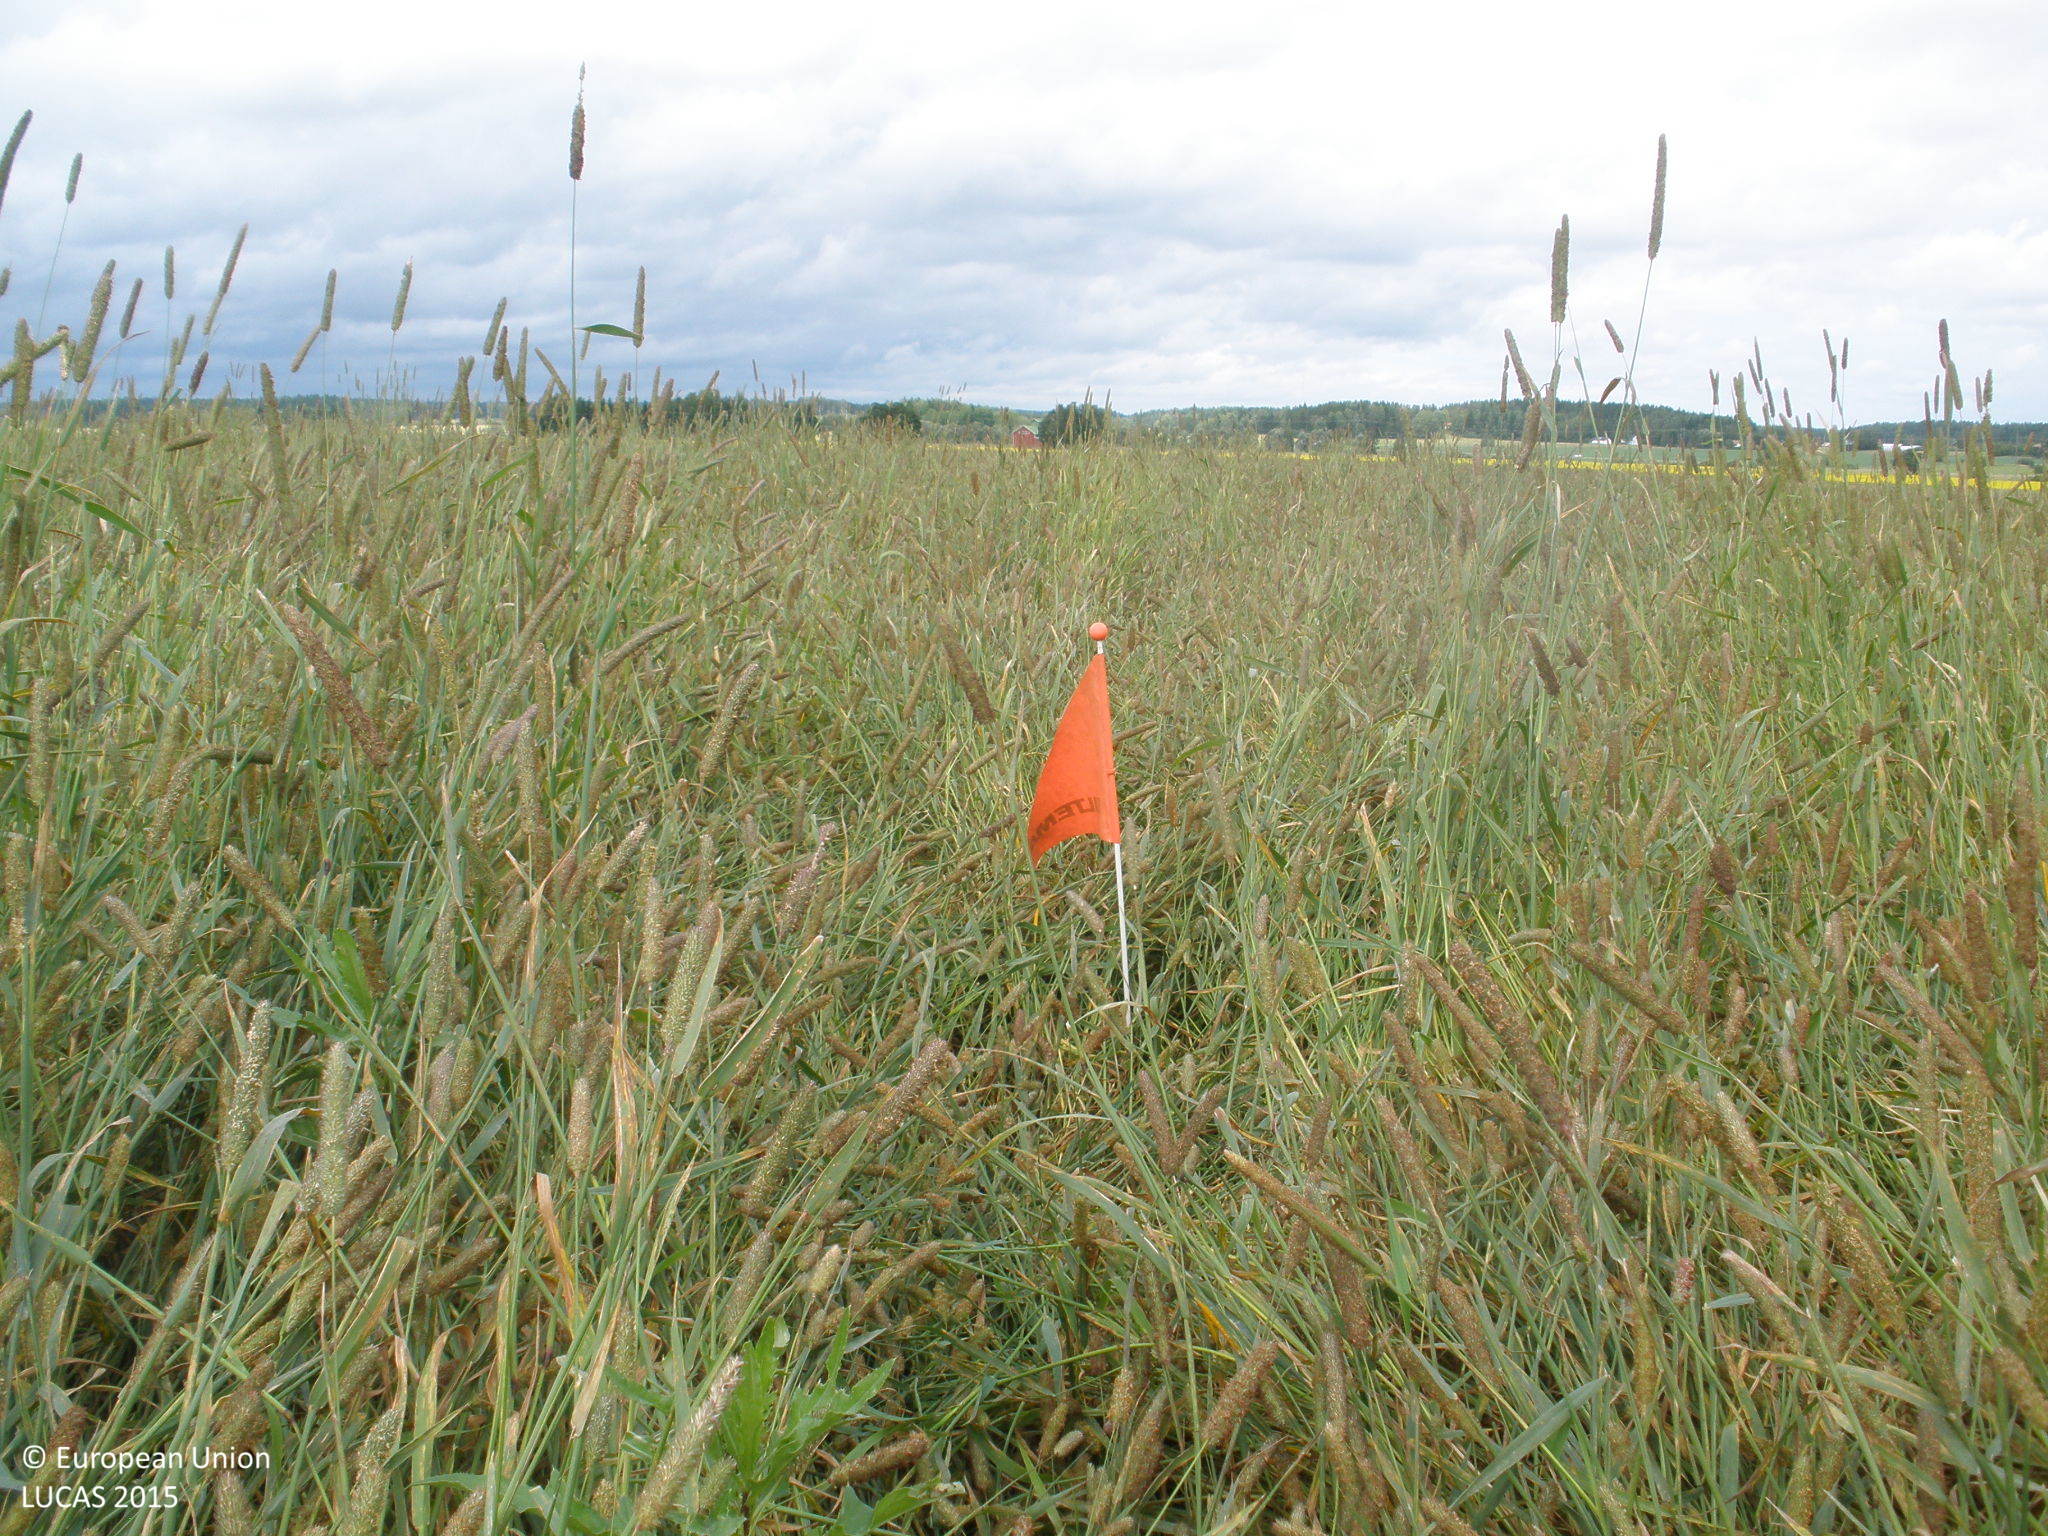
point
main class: Cropland
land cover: Temporary grasslands
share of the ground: > 75 %
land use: Agriculture (excluding fallow land and kitchen gardens)
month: July
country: FI
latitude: 60.6454
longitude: 23.4902
